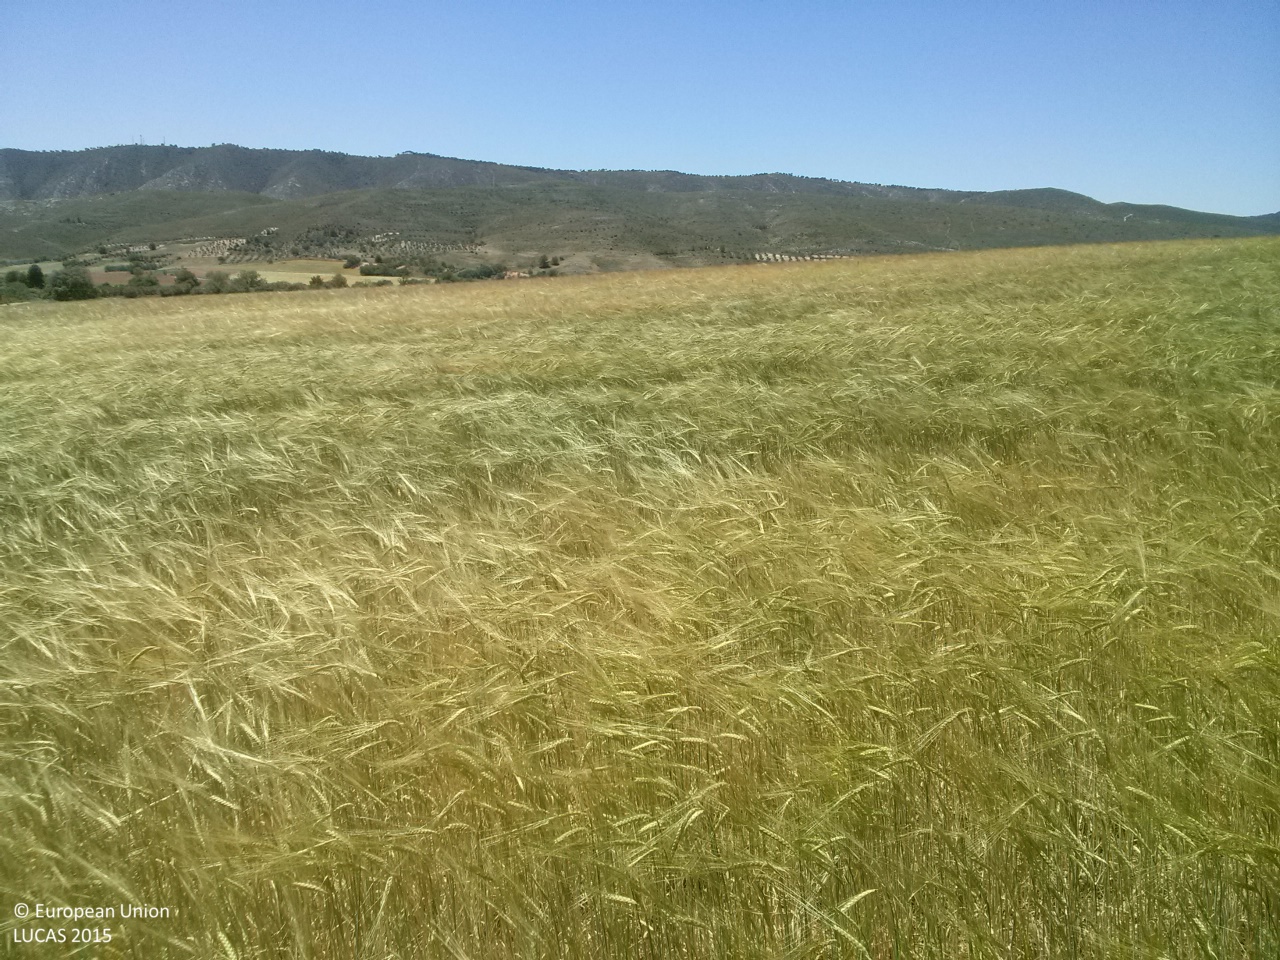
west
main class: Artificial land
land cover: Other artificial areas
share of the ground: < 10 %
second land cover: Barley
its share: > 75 %
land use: Electricity, gas and thermal power distribution
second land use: Agriculture (excluding fallow land and kitchen gardens)
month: May
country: ES
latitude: 40.3074
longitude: -2.7676
